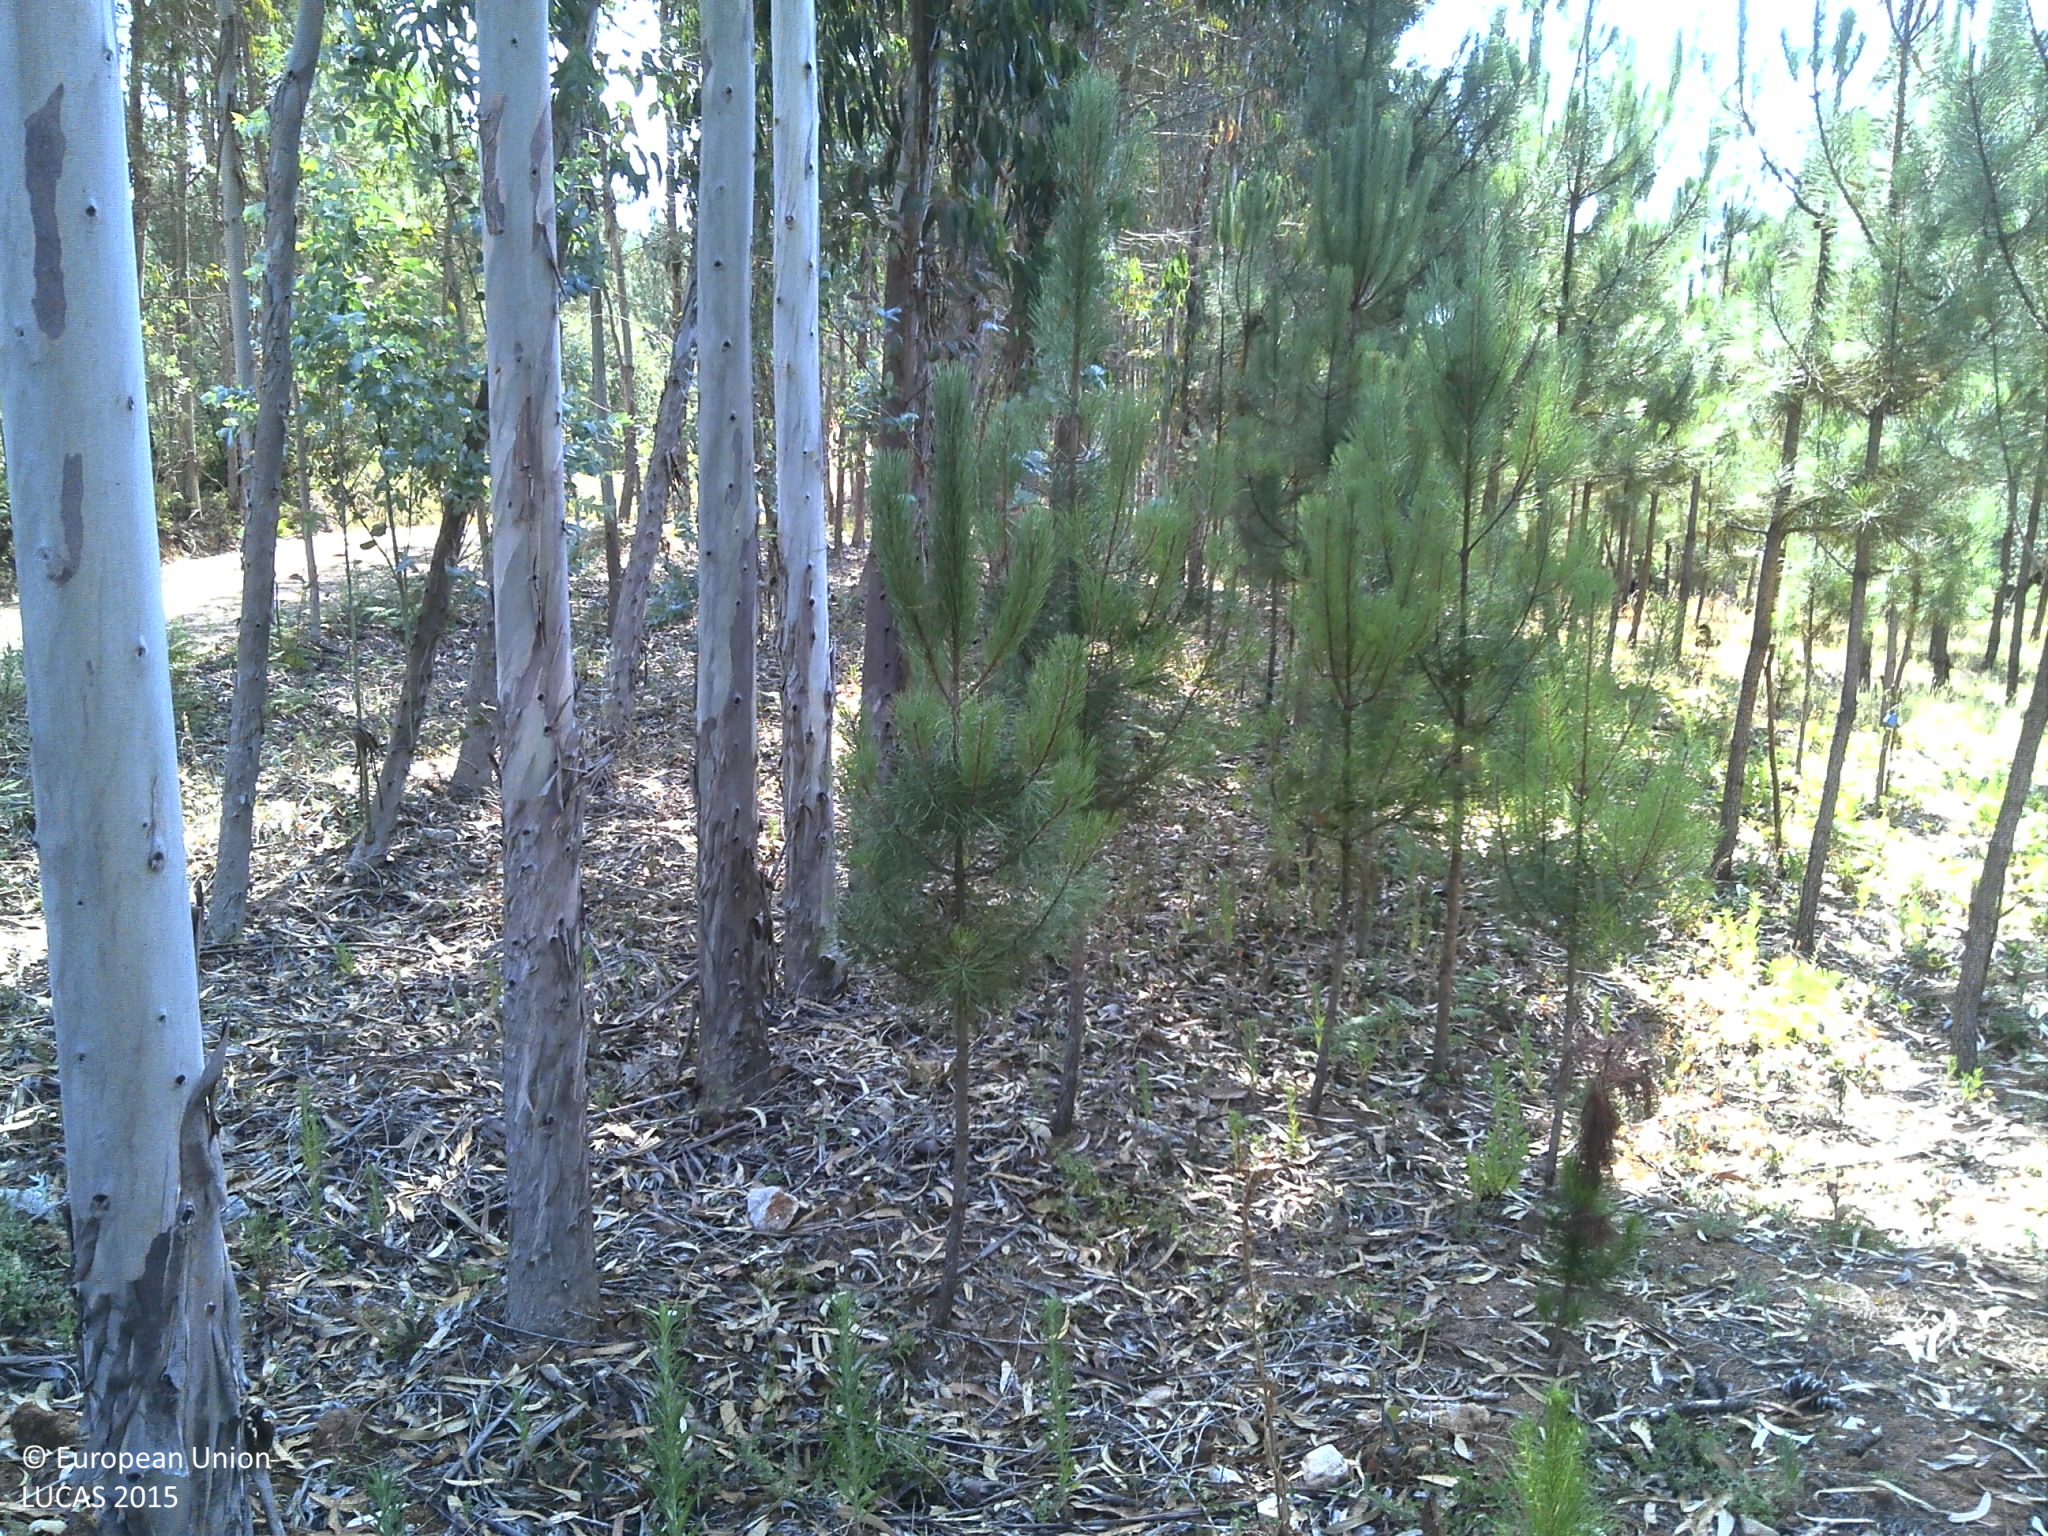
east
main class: Woodland
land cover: Broadleaved woodland
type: exotic forest
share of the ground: 50 - 75 %
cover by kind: broadleaved forest trees 55 %, unconsolidated bare surface 40 %, shrubs 5 %
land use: Forestry
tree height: > 5 m
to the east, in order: Broadleaved woodland; Tracks; Pine dominated coniferous woodland; Broadleaved woodland; Tracks; Broadleaved woodland
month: July
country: PT
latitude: 39.9403
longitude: -8.4653
